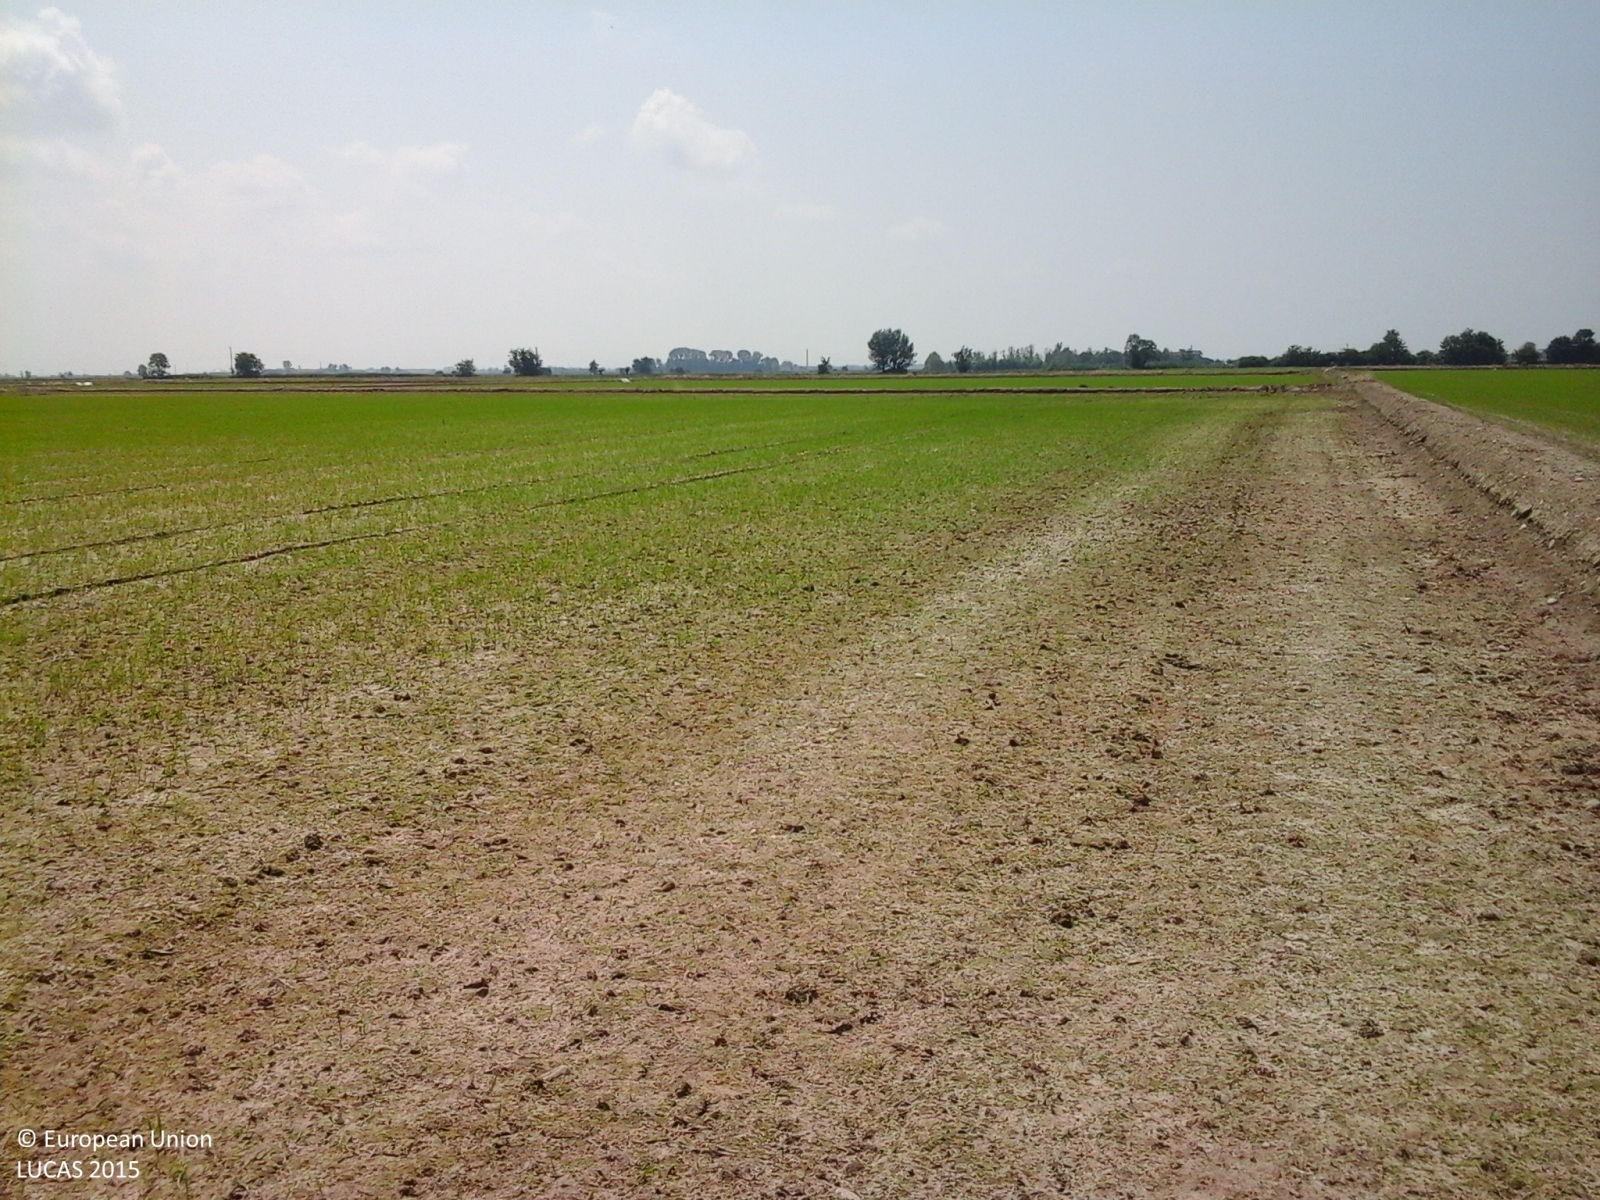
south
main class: Cropland
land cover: Rice
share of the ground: 10 - 25 %
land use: Agriculture (excluding fallow land and kitchen gardens)
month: May
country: IT
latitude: 45.3994
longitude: 8.2272
